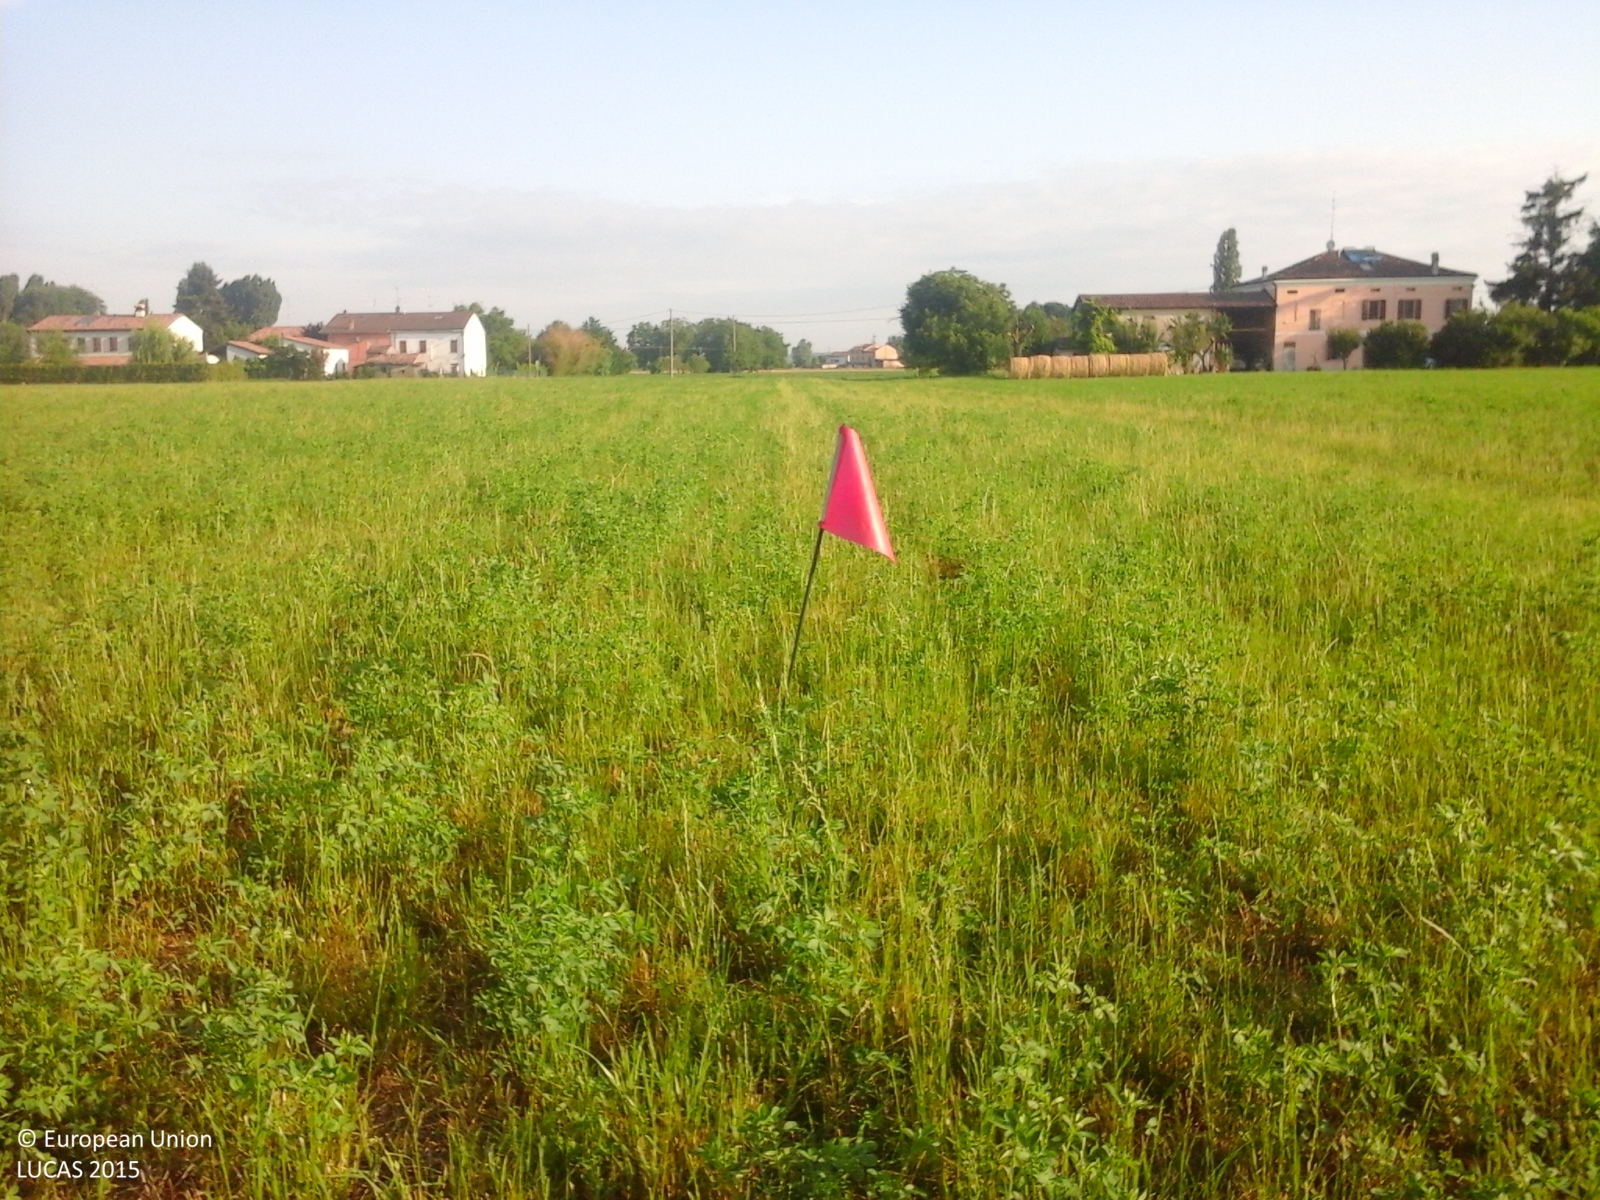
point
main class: Cropland
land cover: Lucerne
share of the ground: > 75 %
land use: Agriculture (excluding fallow land and kitchen gardens)
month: June
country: IT
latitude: 44.9231
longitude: 10.9736
